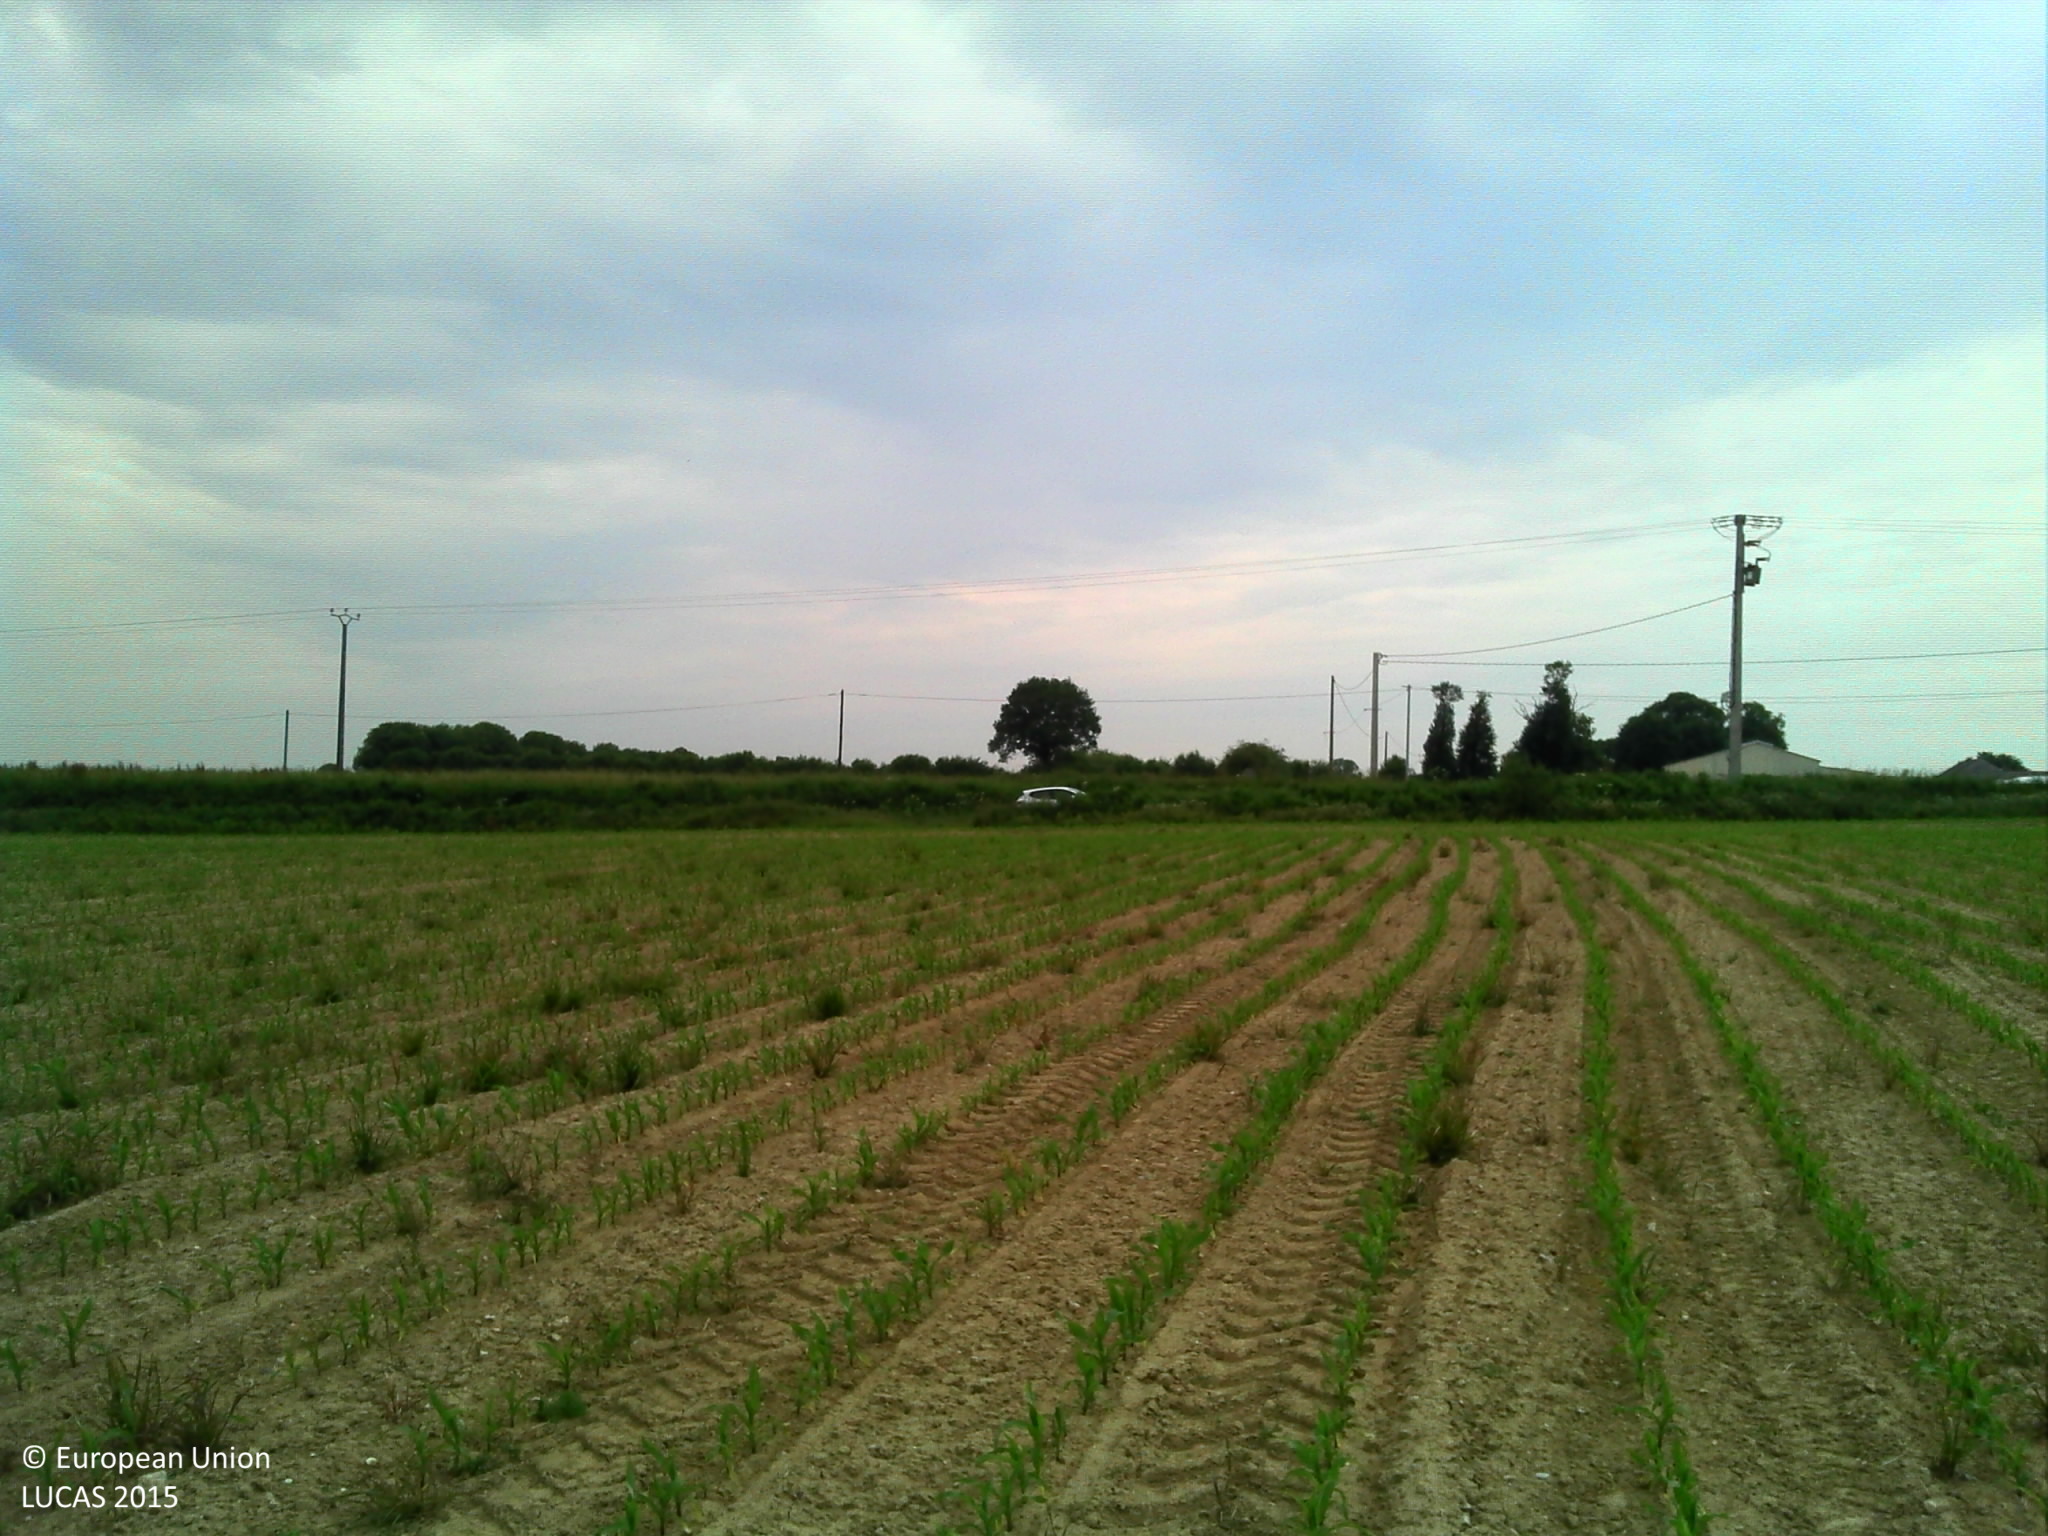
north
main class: Cropland
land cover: Maize
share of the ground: 10 - 25 %
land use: Agriculture (excluding fallow land and kitchen gardens)
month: June
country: FR
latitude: 48.1709
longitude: -2.1164
